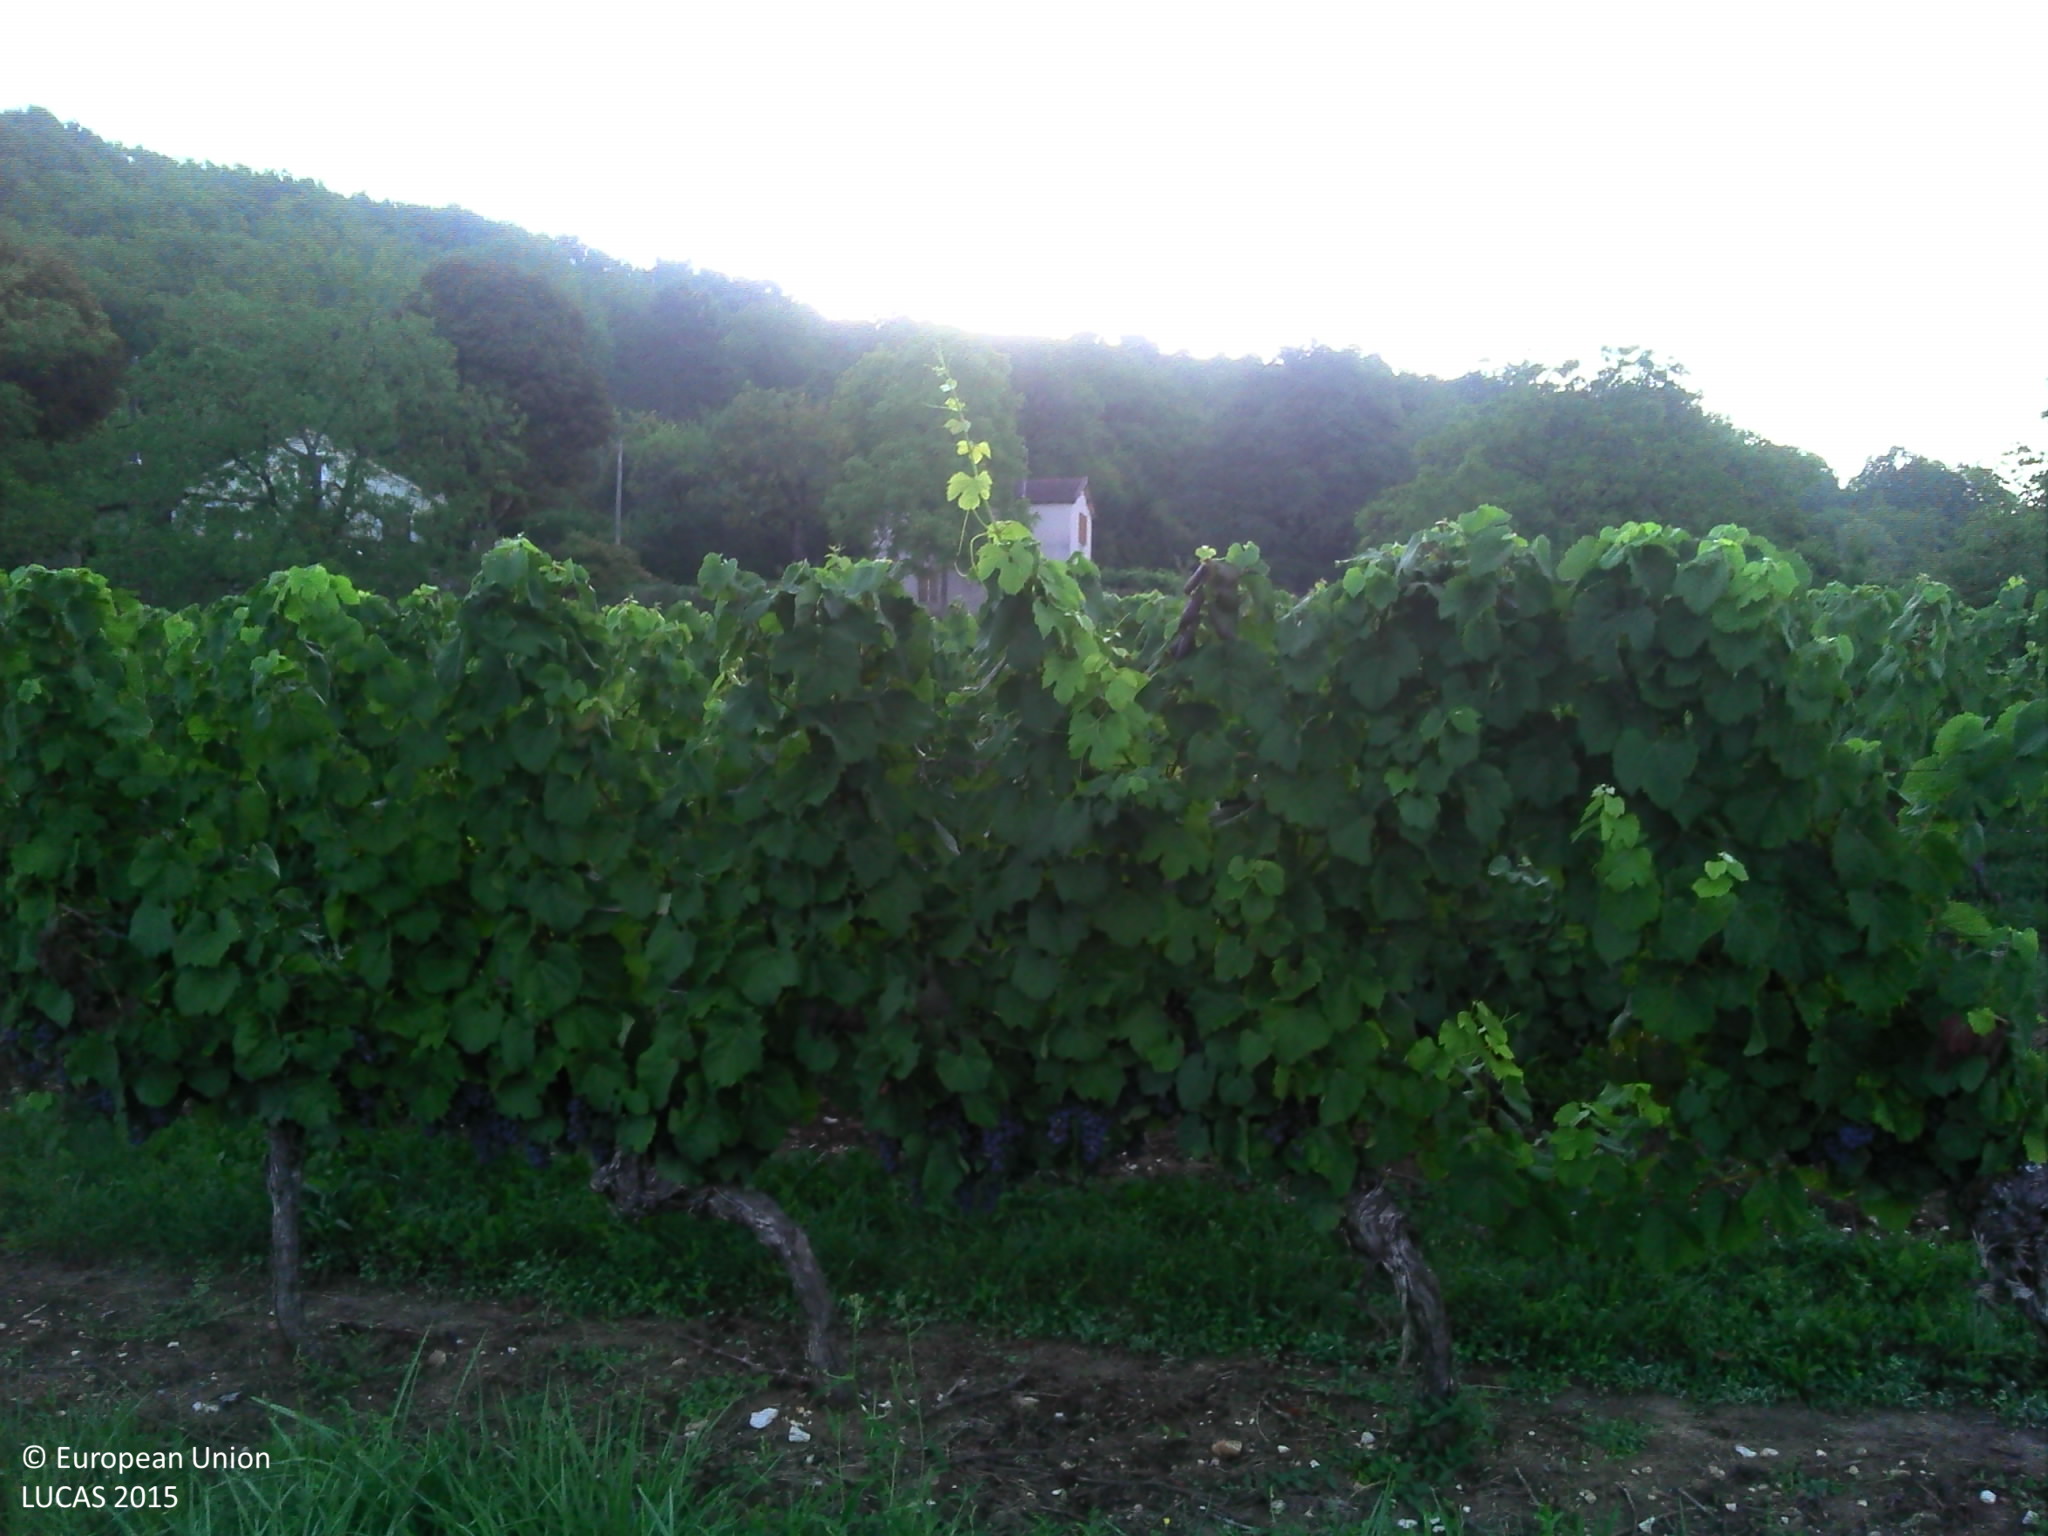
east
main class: Grassland
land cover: Grassland without tree/shrub cover
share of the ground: > 75 %
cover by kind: herbaceous plants 100 %
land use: Agriculture (excluding fallow land and kitchen gardens)
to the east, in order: Grassland without tree/shrub cover; Vineyards; Grassland without tree/shrub cover; Artificial constructions in urban areas; Ditches and canals; Grass margins; Paved roads, cycling and walking lanes; Dry stone walls; Electric lines; Broadleaved woodland; Dry stone walls; Grassland with sparse tree/shrub cover; Dry stone walls; Broadleaved woodland; Dry stone walls; Broadleaved woodland; Dry stone walls; Broadleaved woodland; Dry stone walls; Broadleaved woodland
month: August
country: FR
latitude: 44.4729
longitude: 1.2854
